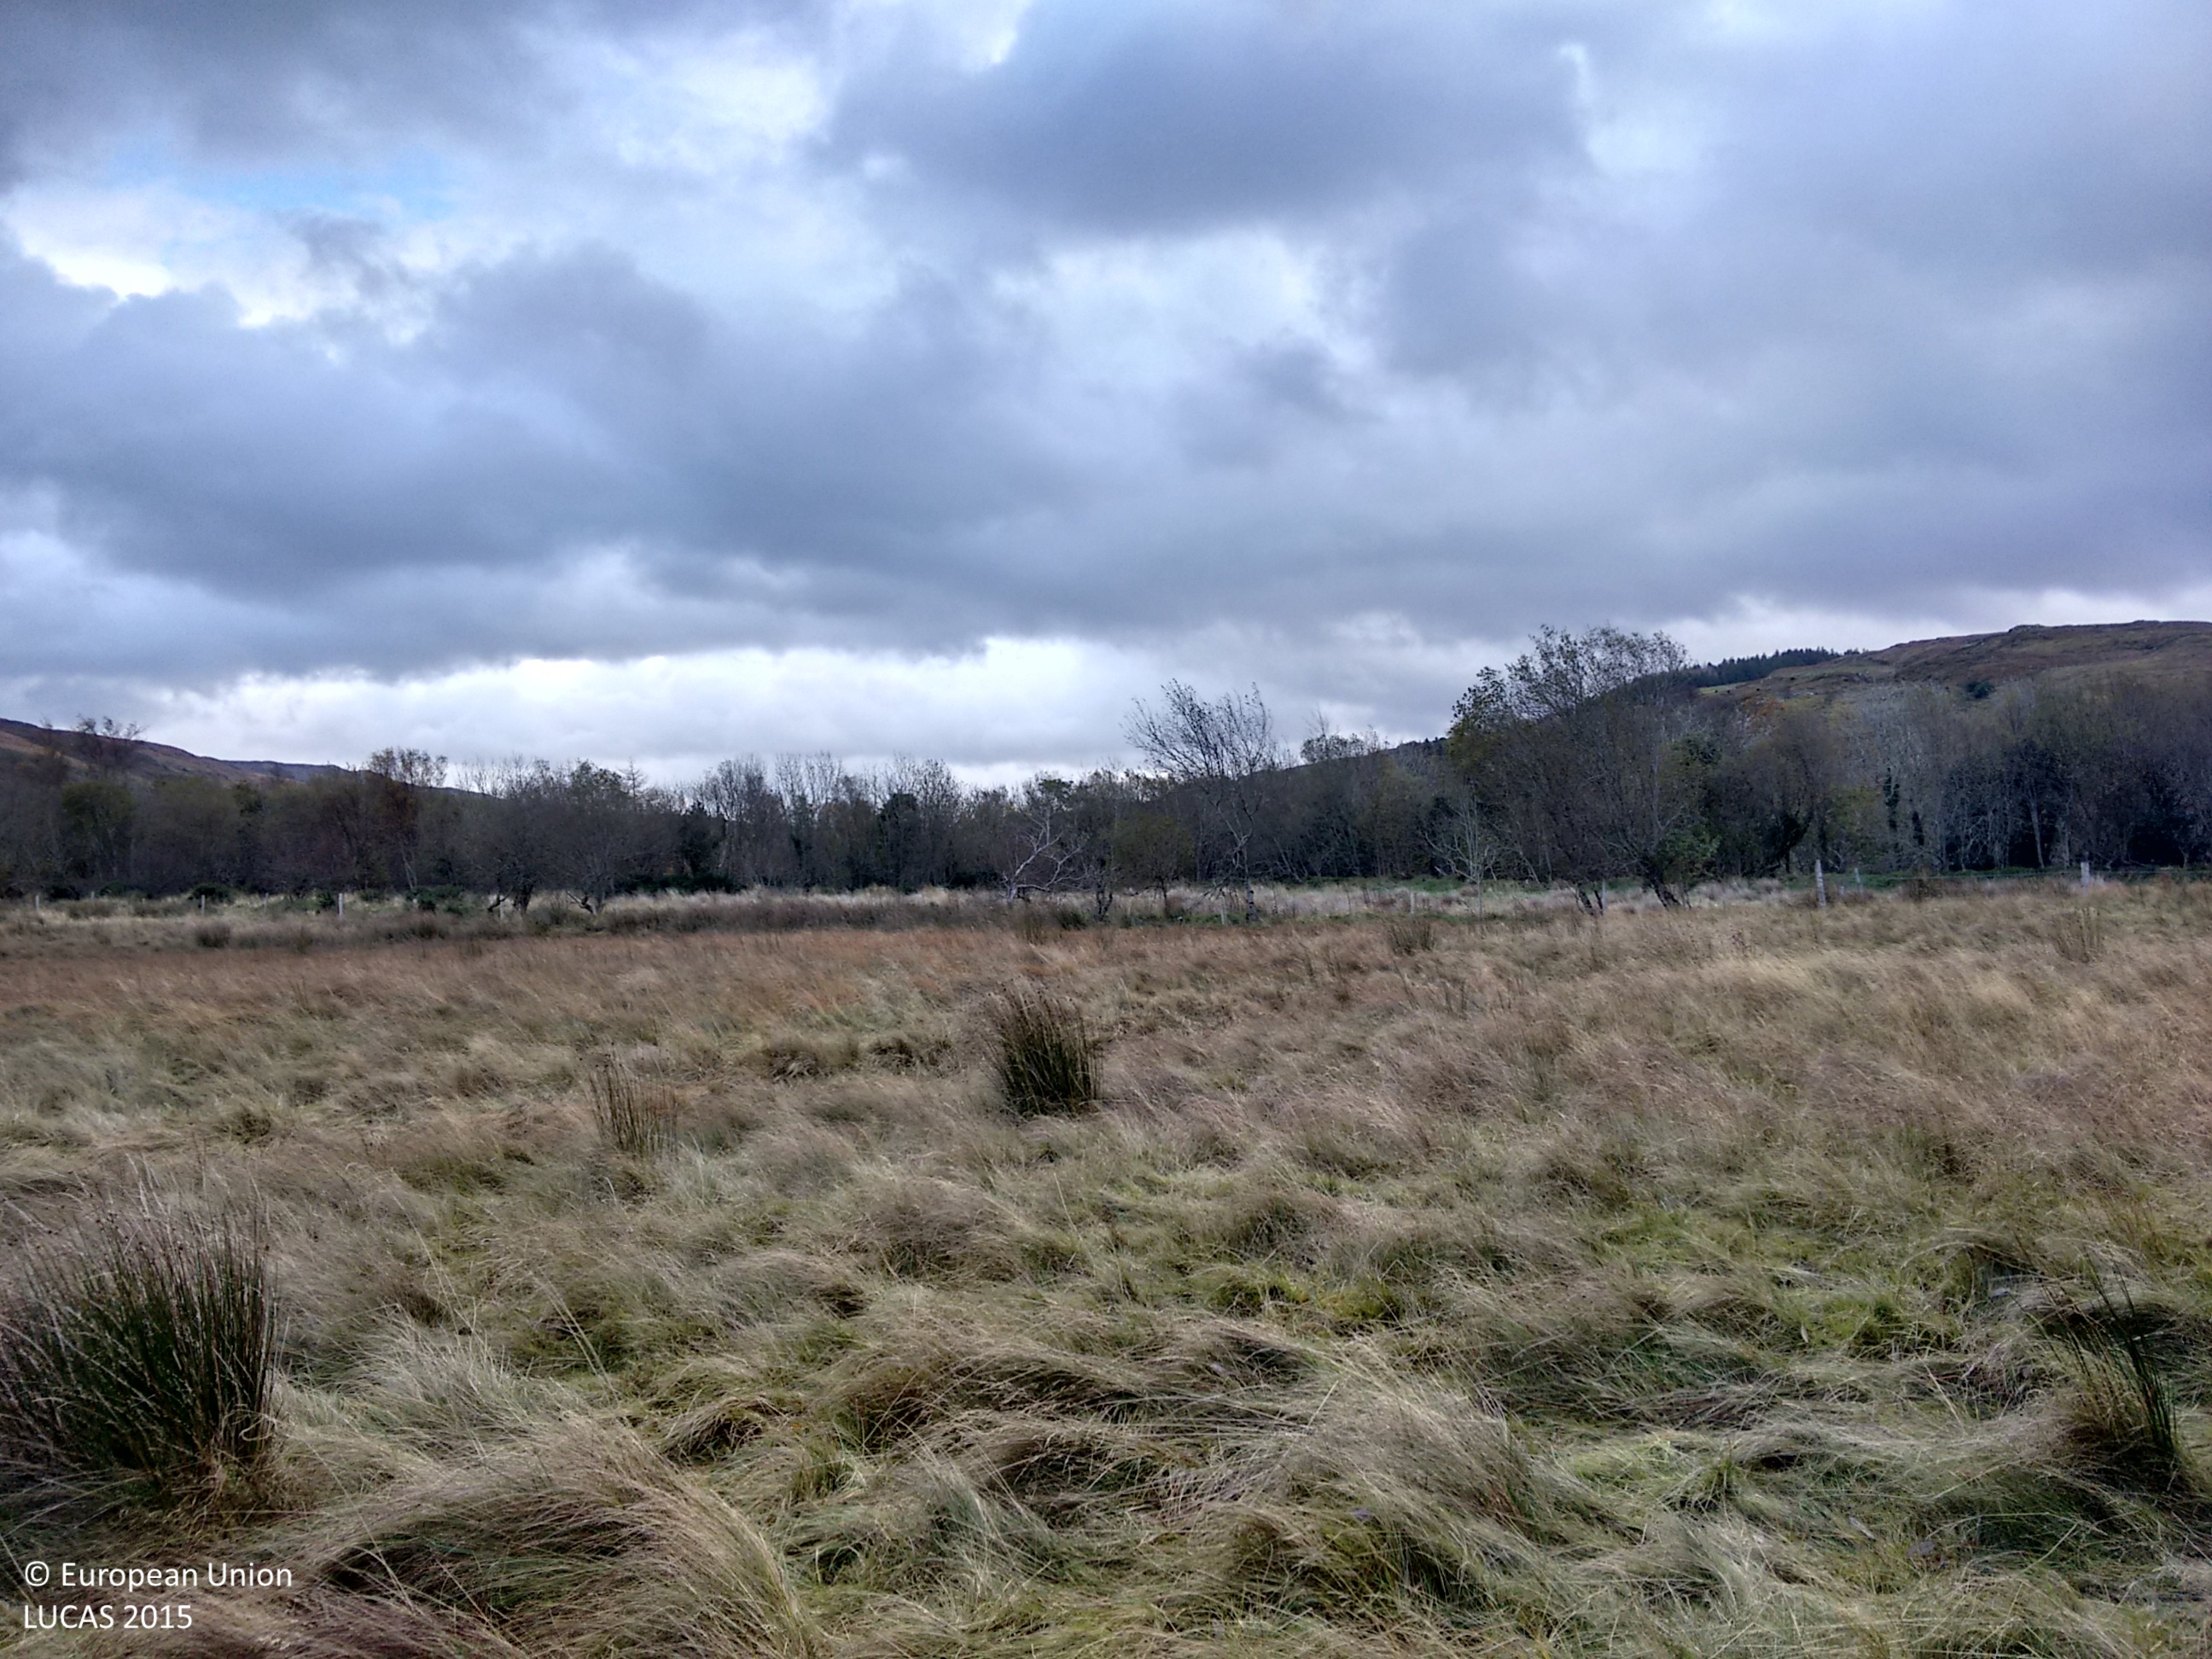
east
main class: Shrubland
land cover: Shrubland without tree cover
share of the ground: > 75 %
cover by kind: shrubs 70 %, herbaceous plants 30 %
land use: Agriculture (excluding fallow land and kitchen gardens)
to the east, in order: Shrubland without tree cover; Electric lines; Abandoned hedges; Fences; Ditches and canals; Grassland without tree/shrub cover; Fences; Ditches and canals; Abandoned hedges; Grassland without tree/shrub cover; Fences; Ditches and canals; Broadleaved woodland; Fences; Broadleaved woodland; Rivers and streams; Broadleaved woodland; Ditches and canals; Shruby margins; Fences; Grassland without tree/shrub cover
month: November
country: IE
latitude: 54.7848
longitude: -8.2660
